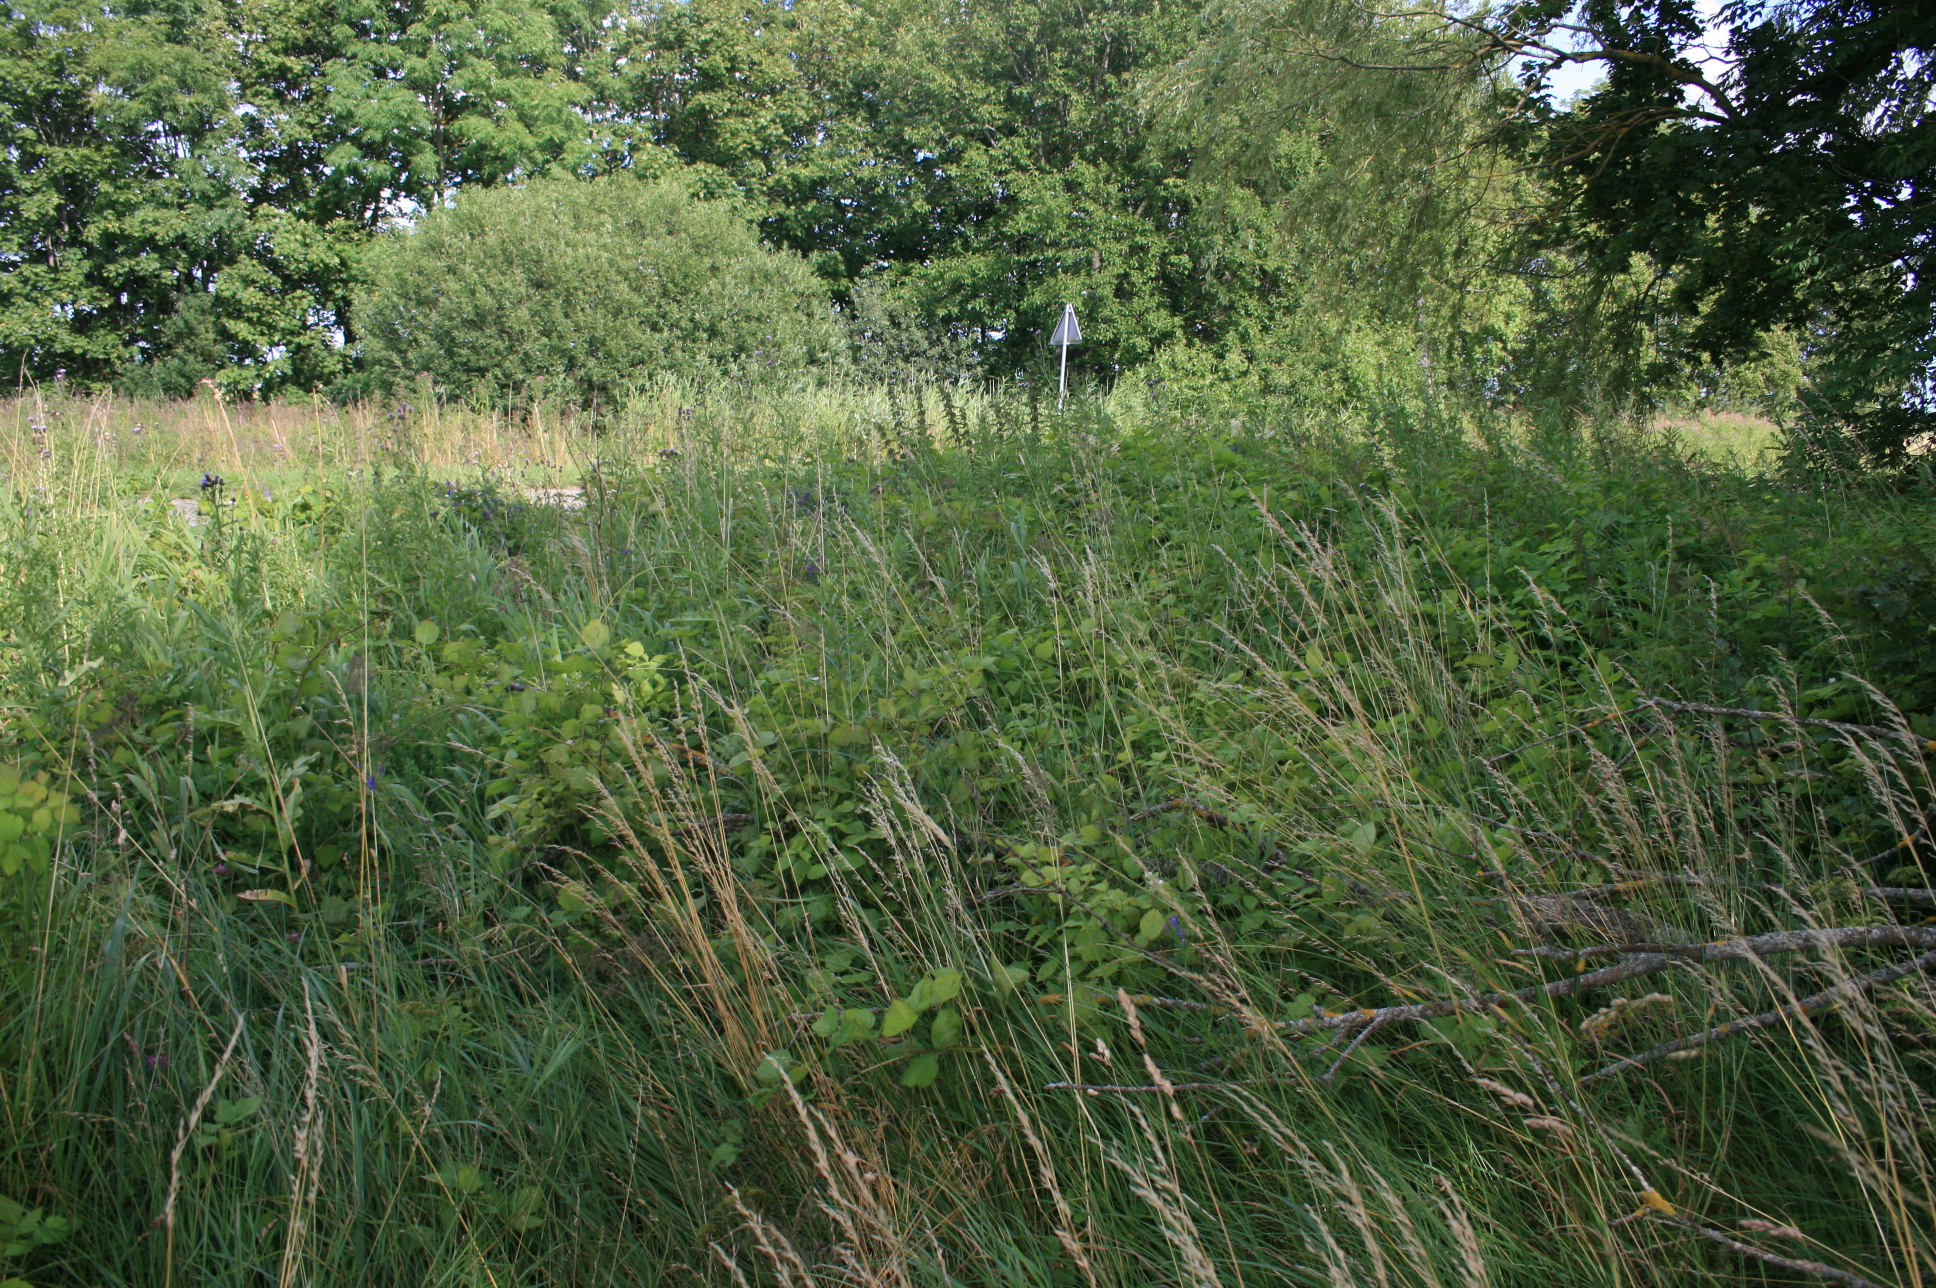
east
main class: Grassland
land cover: Grassland with sparse tree/shrub cover
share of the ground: > 75 %
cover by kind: herbaceous plants 90 %, broadleaved forest trees 5 %, shrubs 5 %
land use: Fallow land
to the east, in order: Grassland with sparse tree/shrub cover; Paved roads, cycling and walking lanes; Spontaneously vegetated surfaces; Broadleaved woodland; Shruby margins; Common wheat
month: July
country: LT
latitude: 55.5023
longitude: 21.3314
